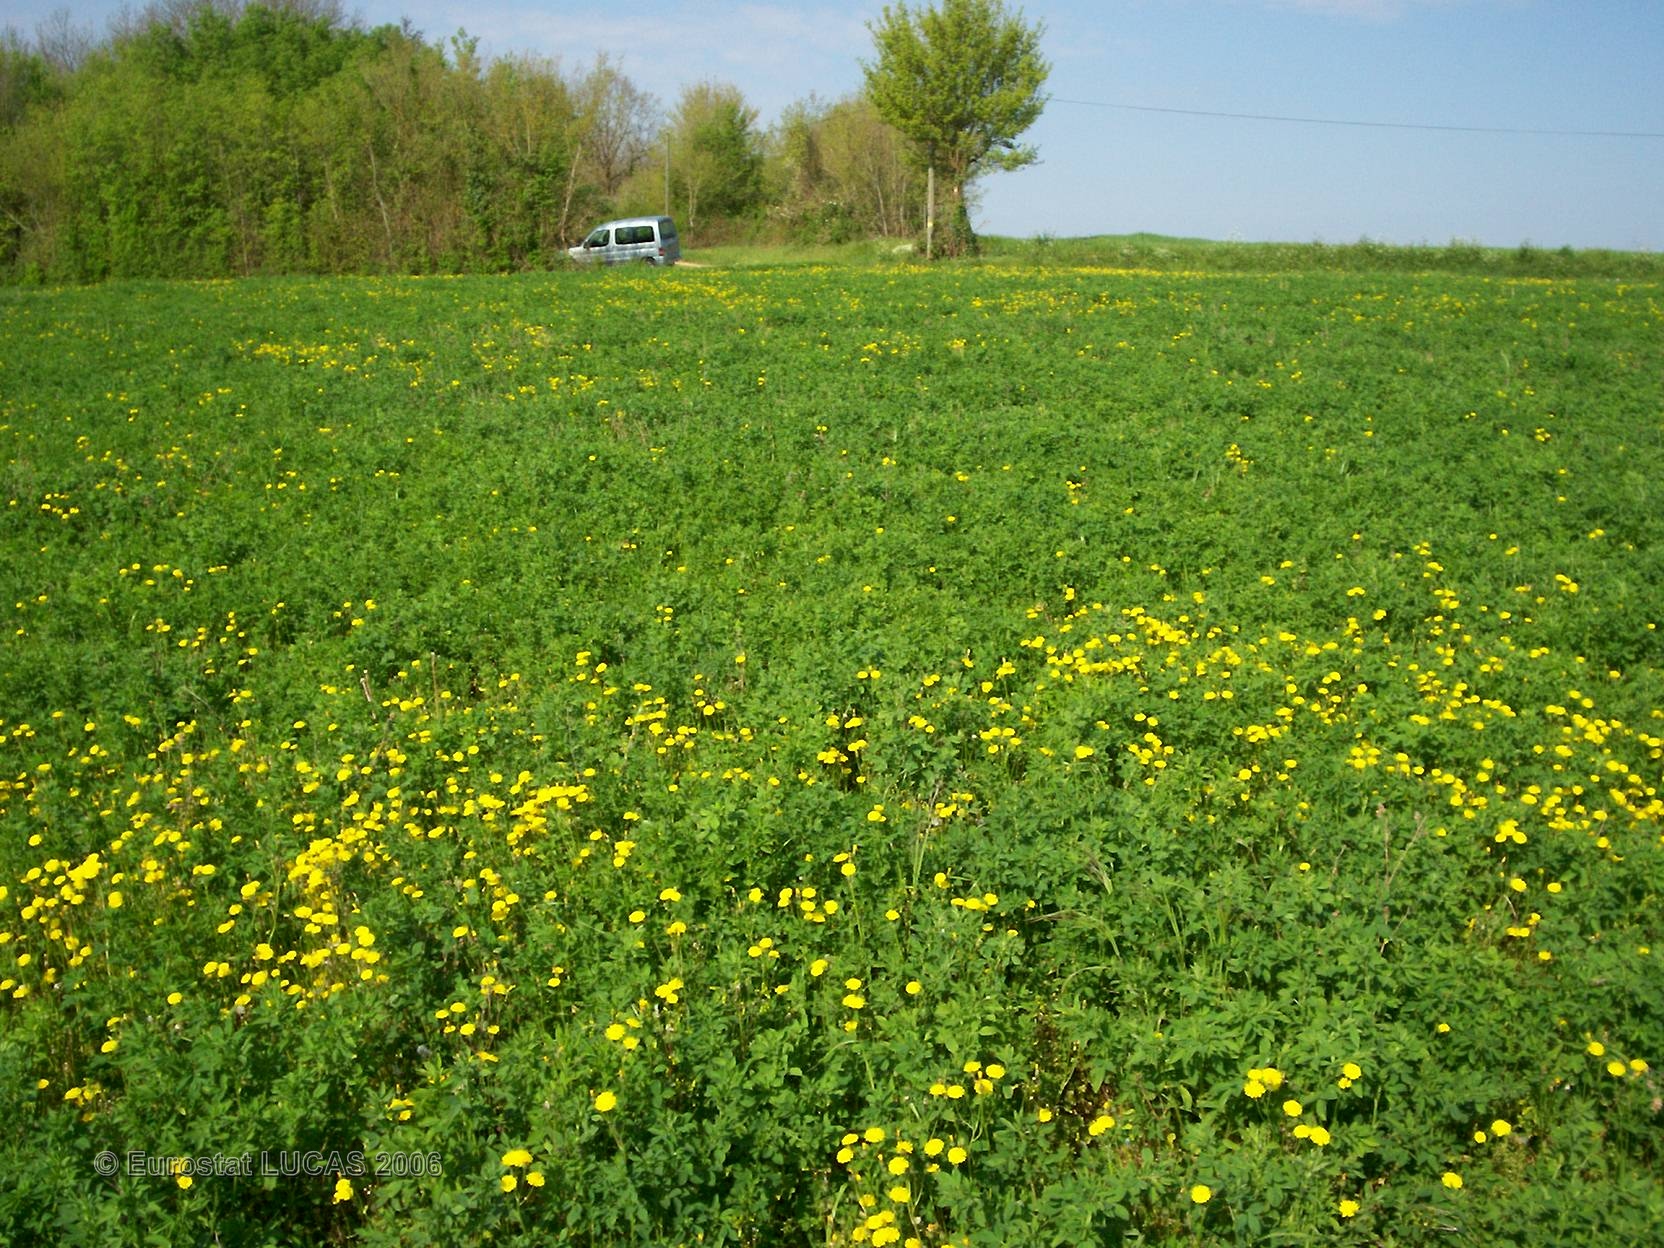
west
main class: Cropland
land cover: Lucerne
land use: Agriculture (excluding fallow land and kitchen gardens)
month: April
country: FR
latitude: 45.5665
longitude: 0.5182
